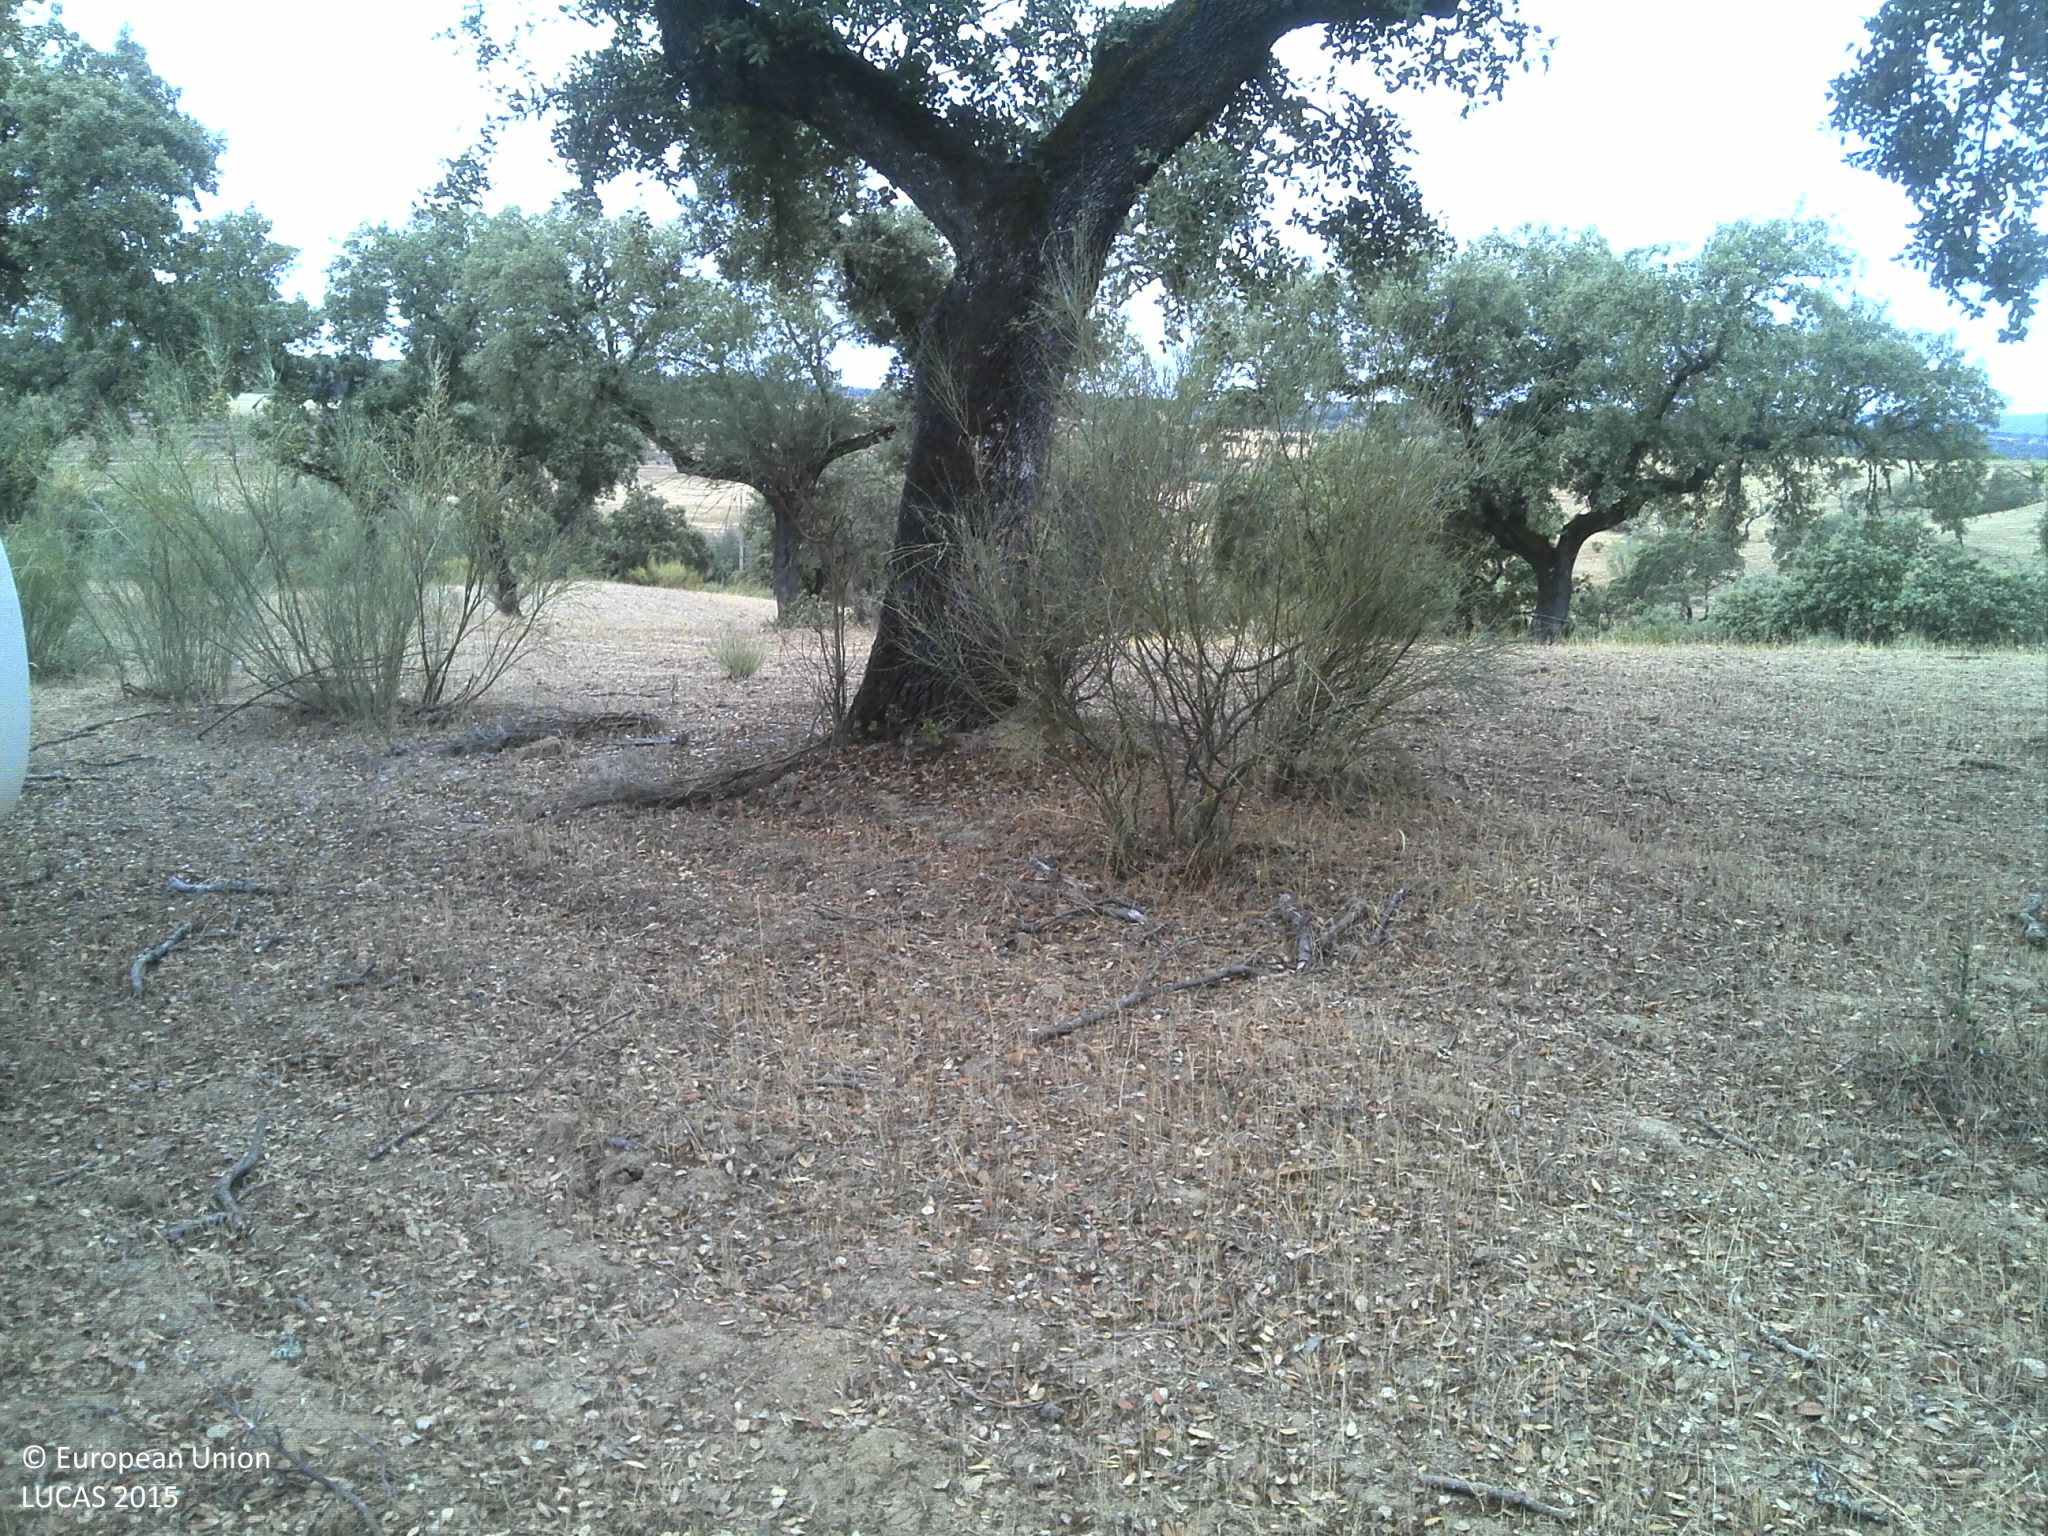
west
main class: Woodland
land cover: Broadleaved woodland
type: broadleaved evergreen forest
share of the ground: 25 - 50 %
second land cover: Spontaneously vegetated surfaces
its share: 10 - 25 %
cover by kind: broadleaved forest trees 45 %, unconsolidated bare surface 40 %, herbaceous plants 15 %
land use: Forestry
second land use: Agriculture (excluding fallow land and kitchen gardens)
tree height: > 5 m
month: July
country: PT
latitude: 39.7938
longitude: -7.3676
